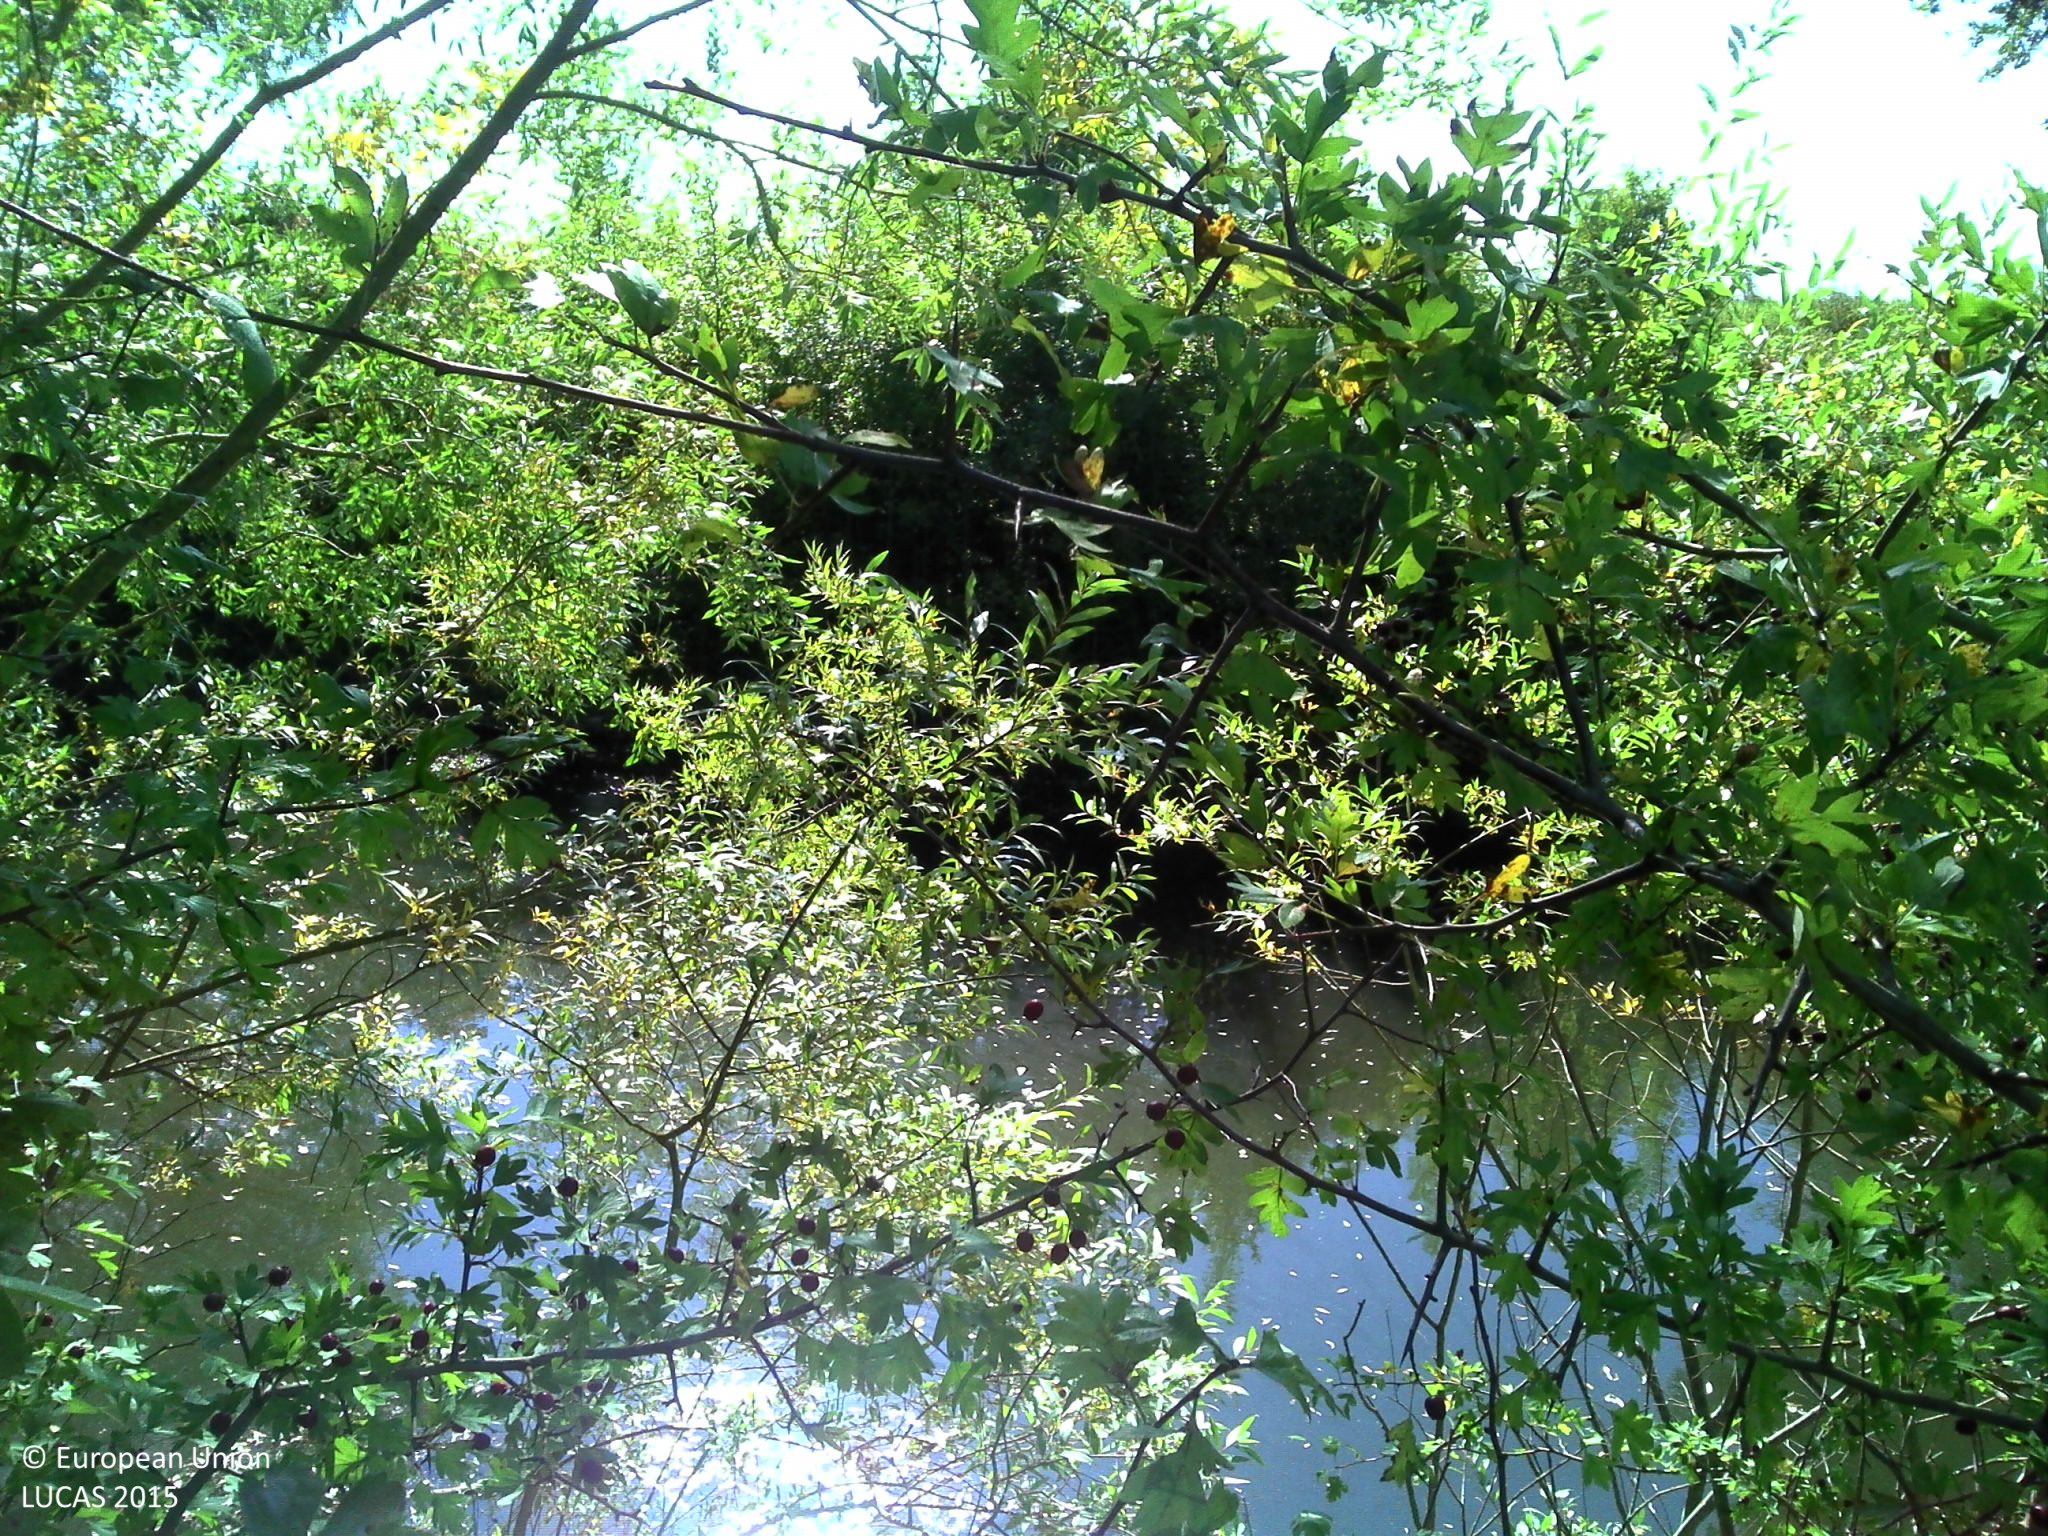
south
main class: Woodland
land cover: Broadleaved woodland
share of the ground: > 75 %
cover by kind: broadleaved forest trees 100 %
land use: Semi-natural and natural areas not in use
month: September
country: FR
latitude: 48.1626
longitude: 4.2292
